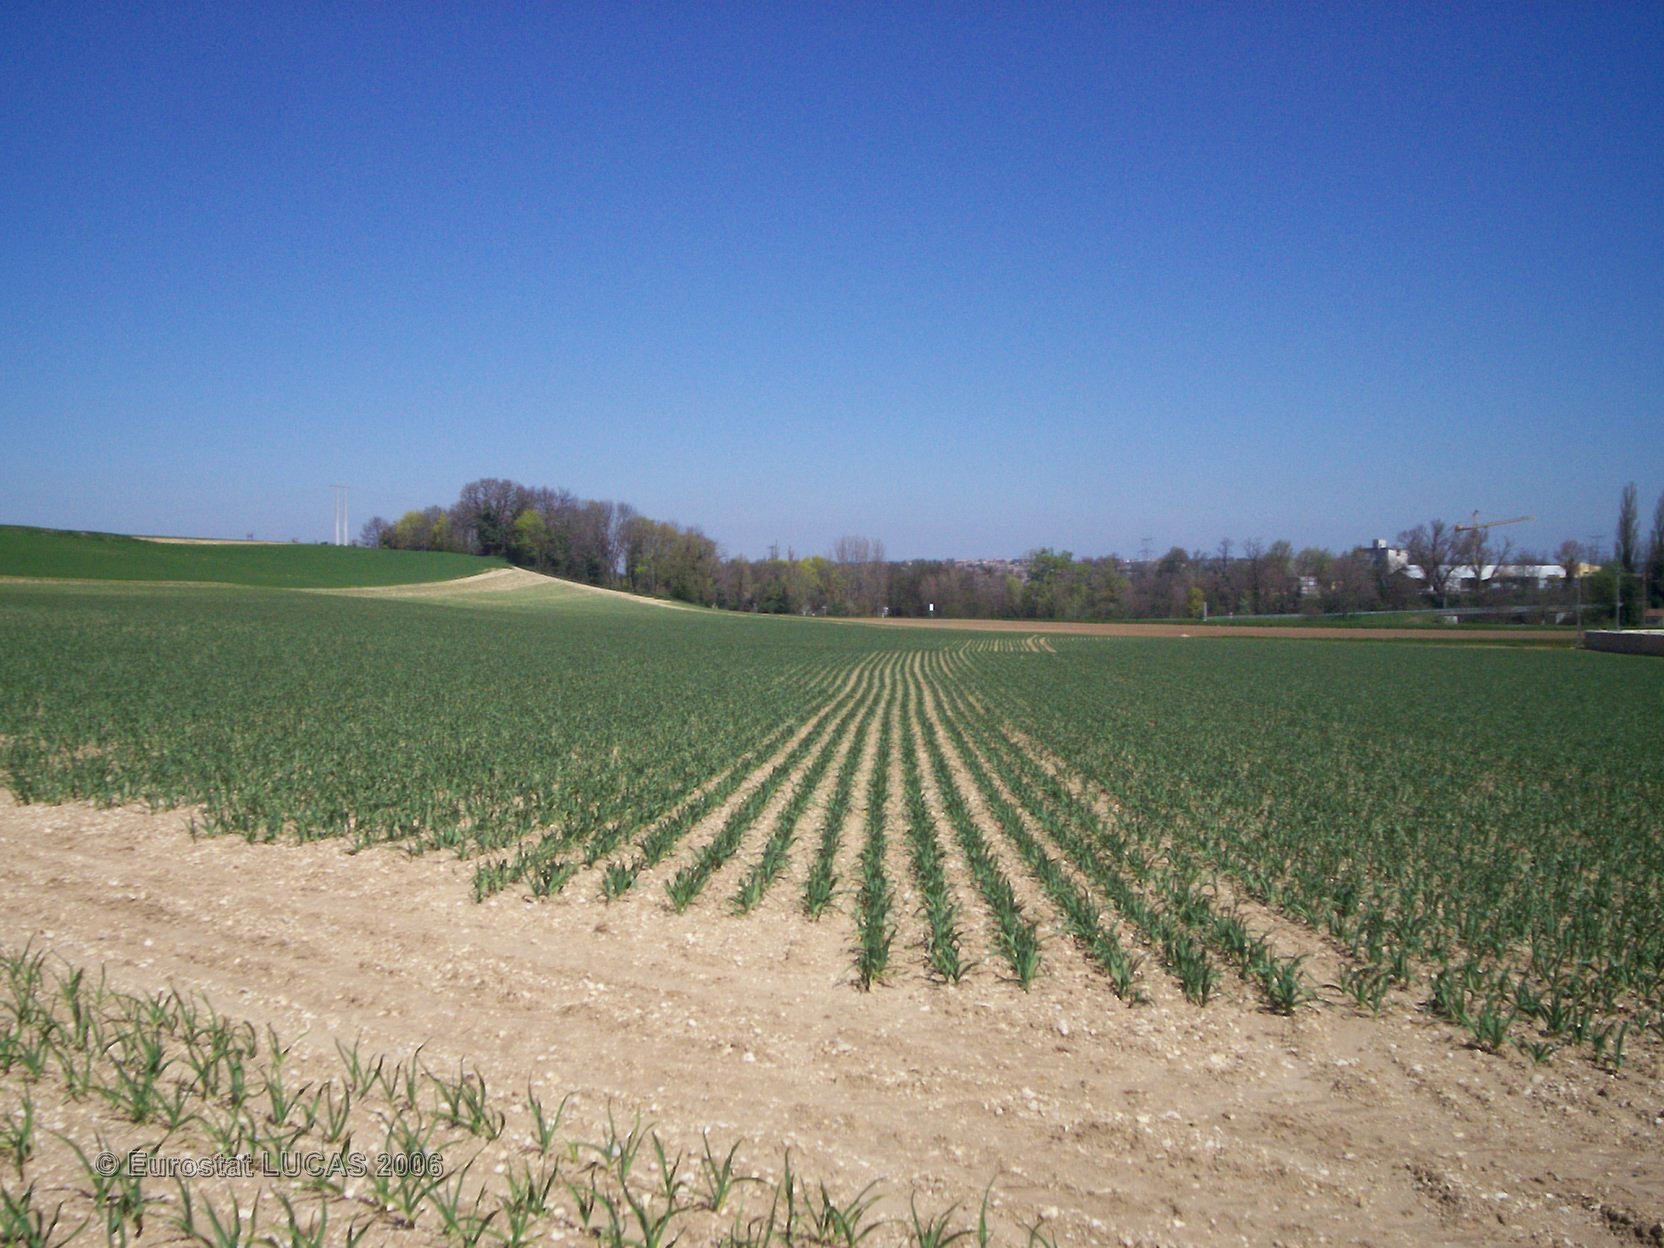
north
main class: Cropland
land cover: Other fresh vegetables
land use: Agriculture (excluding fallow land and kitchen gardens)
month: April
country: FR
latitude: 44.7319
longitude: 4.9176
